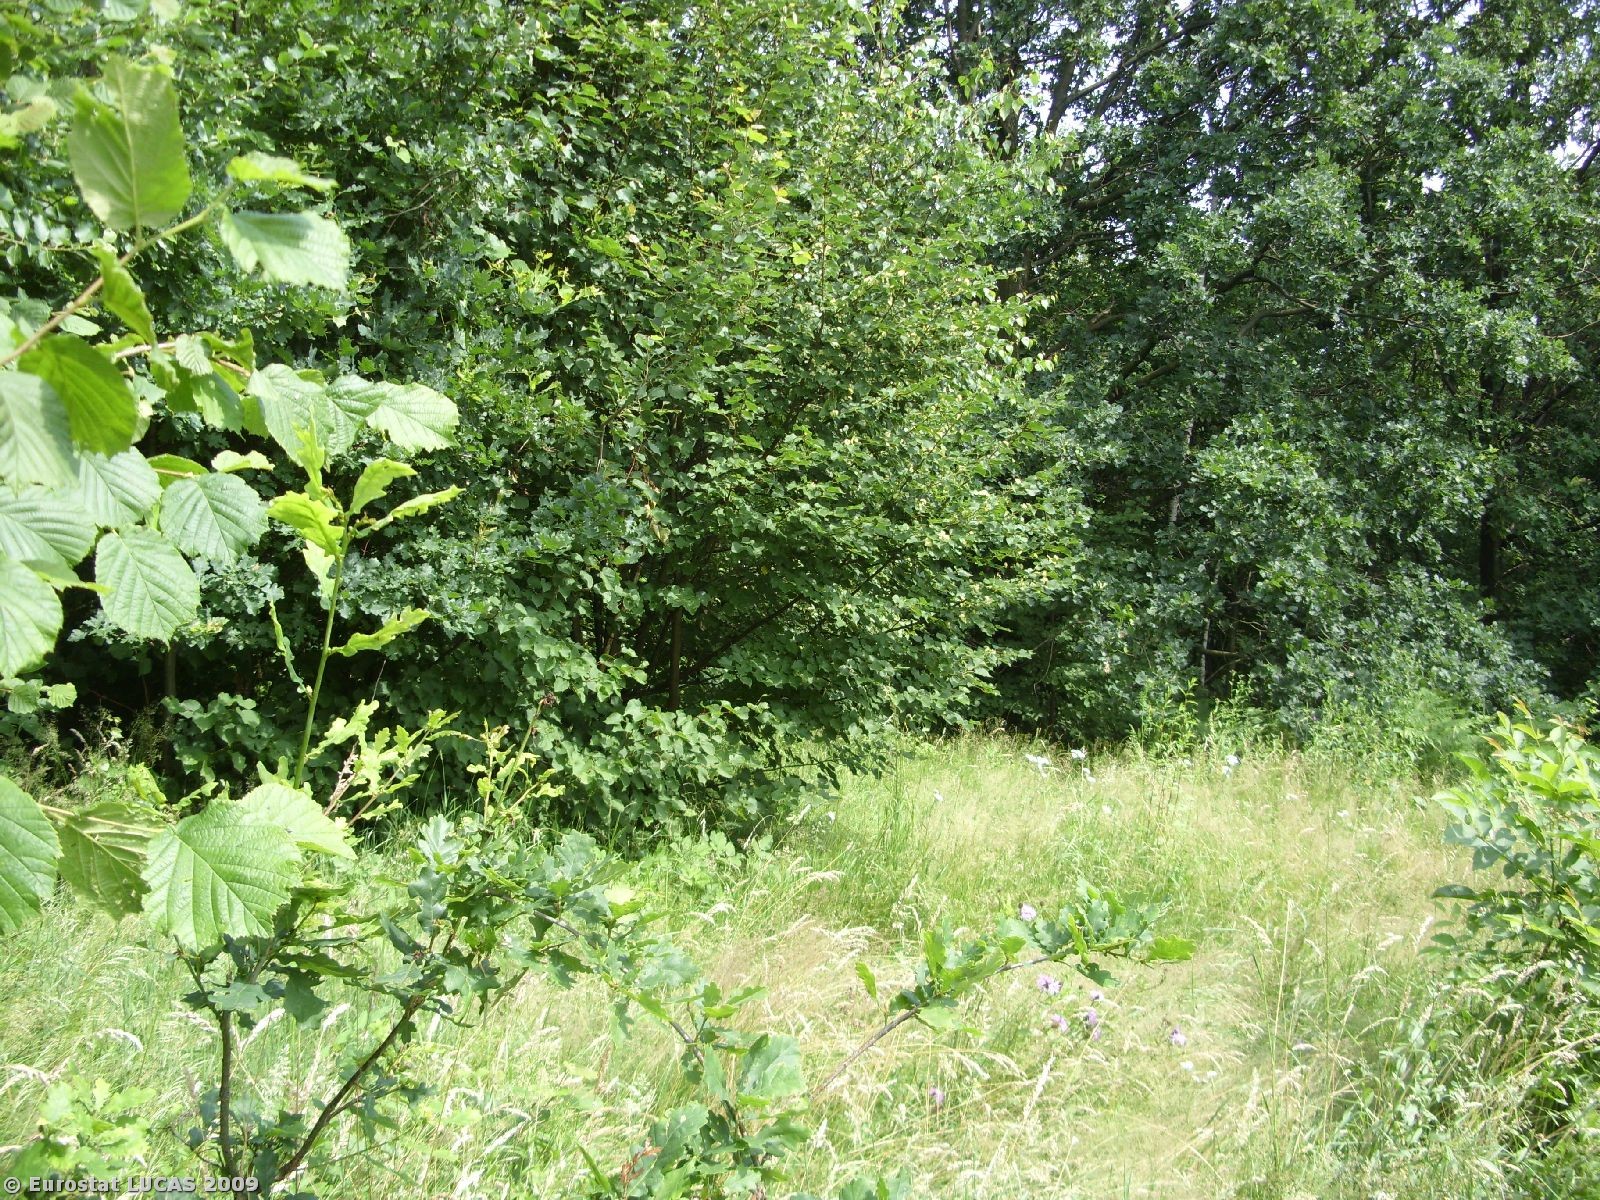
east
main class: Grassland
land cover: Grassland with sparse tree/shrub cover
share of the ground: > 75 %
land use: Unused
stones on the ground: < 10 %
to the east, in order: Grassland with sparse tree/shrub cover; Electric lines; Broadleaved woodland
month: July
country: PL
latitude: 49.8923
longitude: 19.9565
